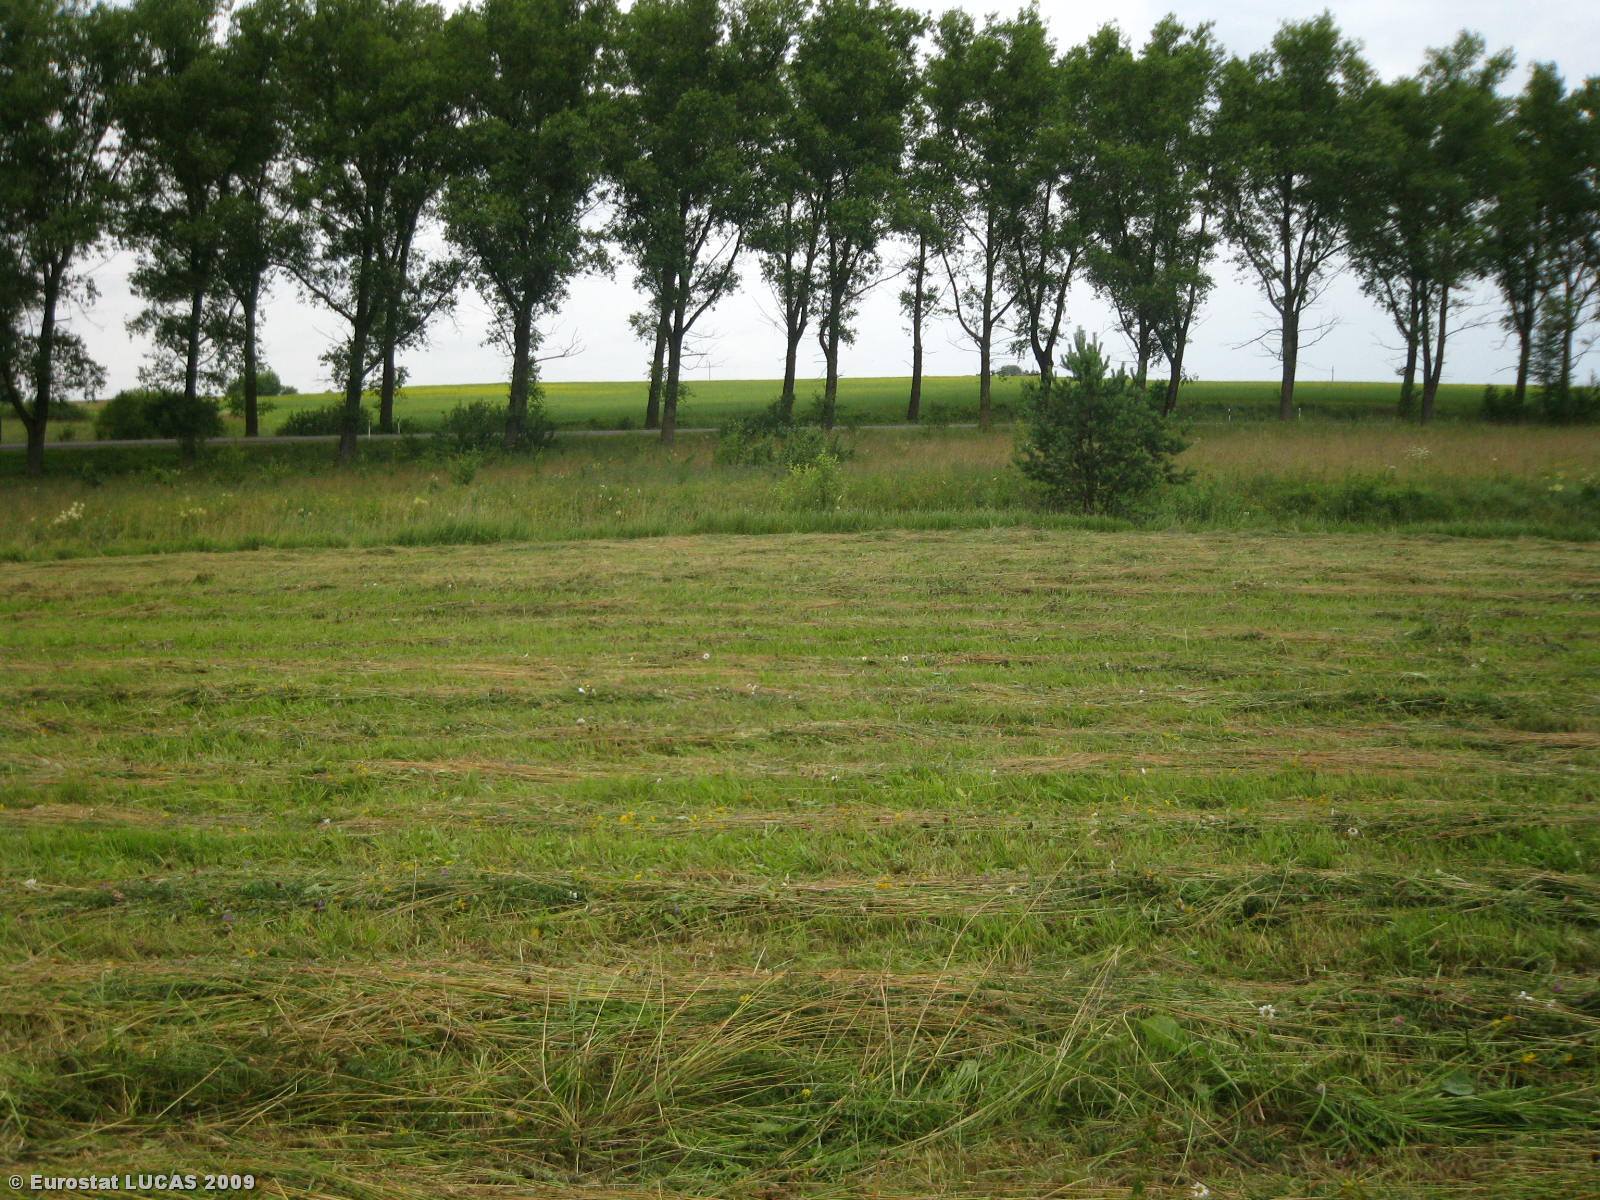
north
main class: Woodland
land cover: Broadleaved woodland
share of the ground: 25 - 50 %
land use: Forestry
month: July
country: LT
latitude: 55.2226
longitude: 24.8710
